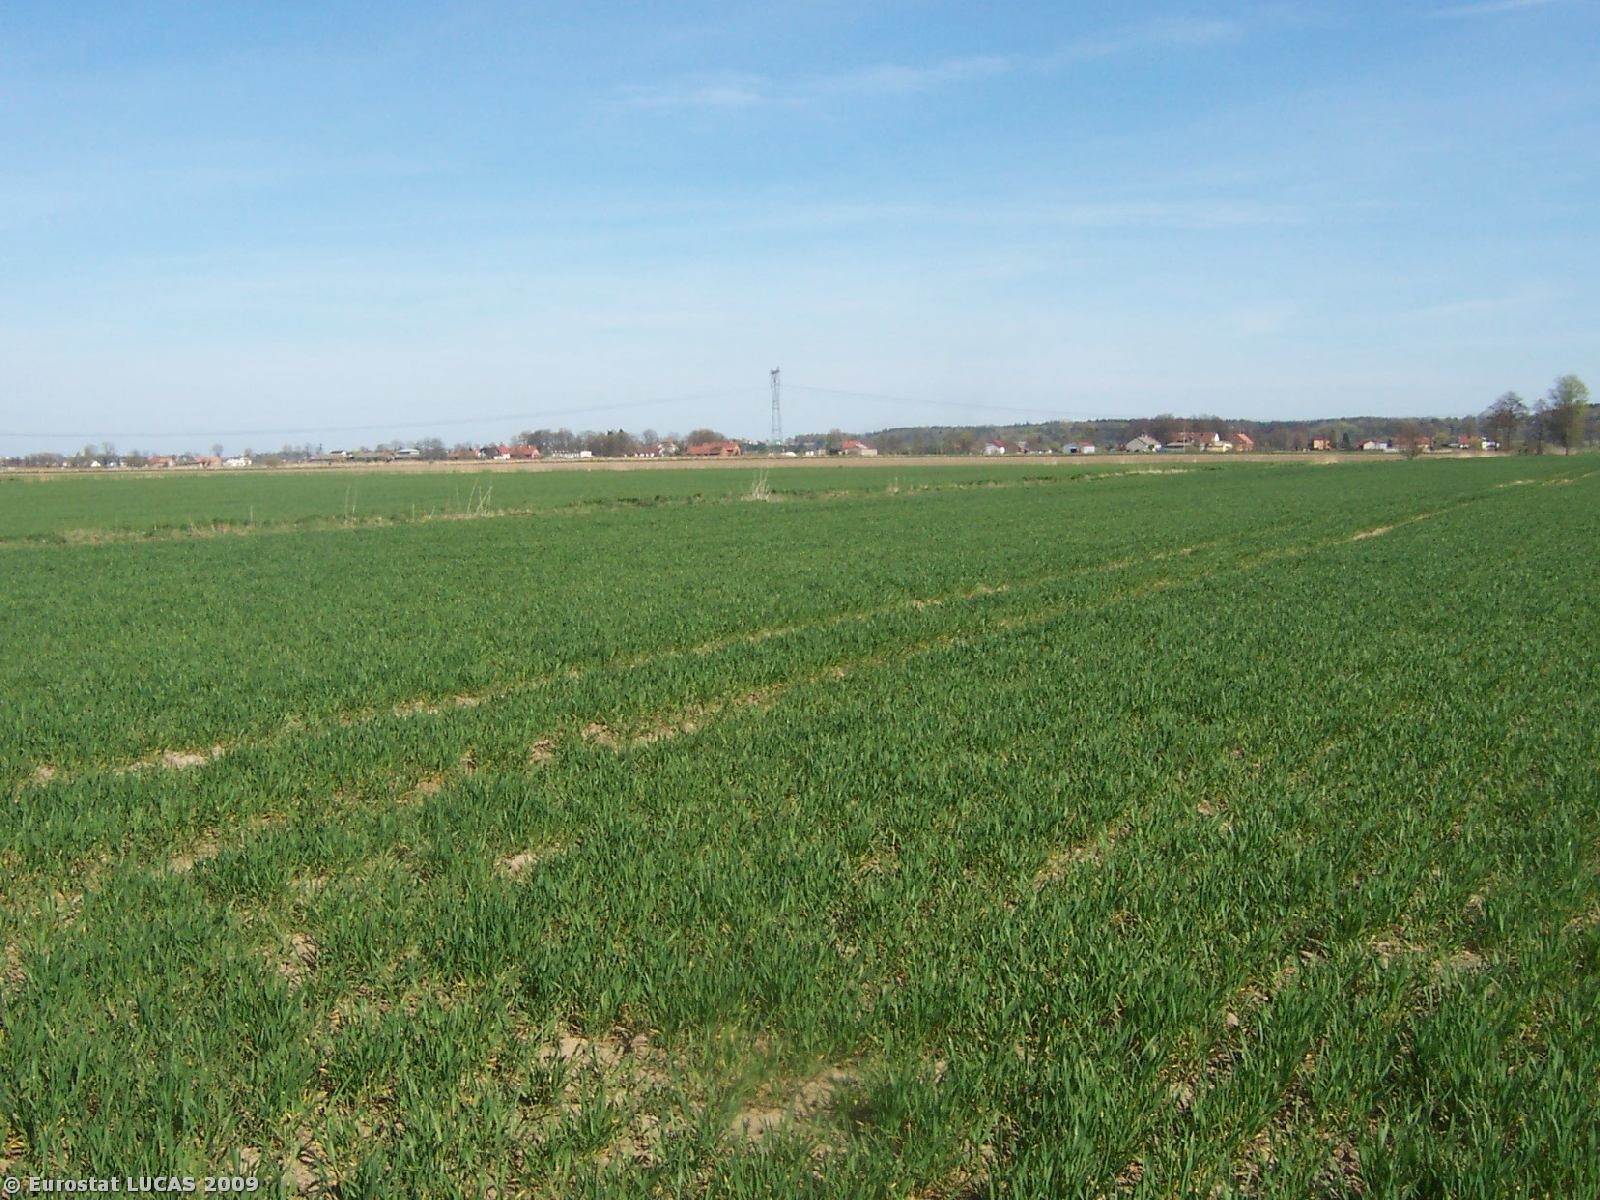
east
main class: Cropland
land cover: Common wheat
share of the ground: 25 - 50 %
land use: Agriculture (excluding fallow land and kitchen gardens)
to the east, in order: Common wheat; Ditches and canals; Common wheat; Ditches and canals; Common wheat
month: April
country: PL
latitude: 54.0109
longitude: 18.9480
